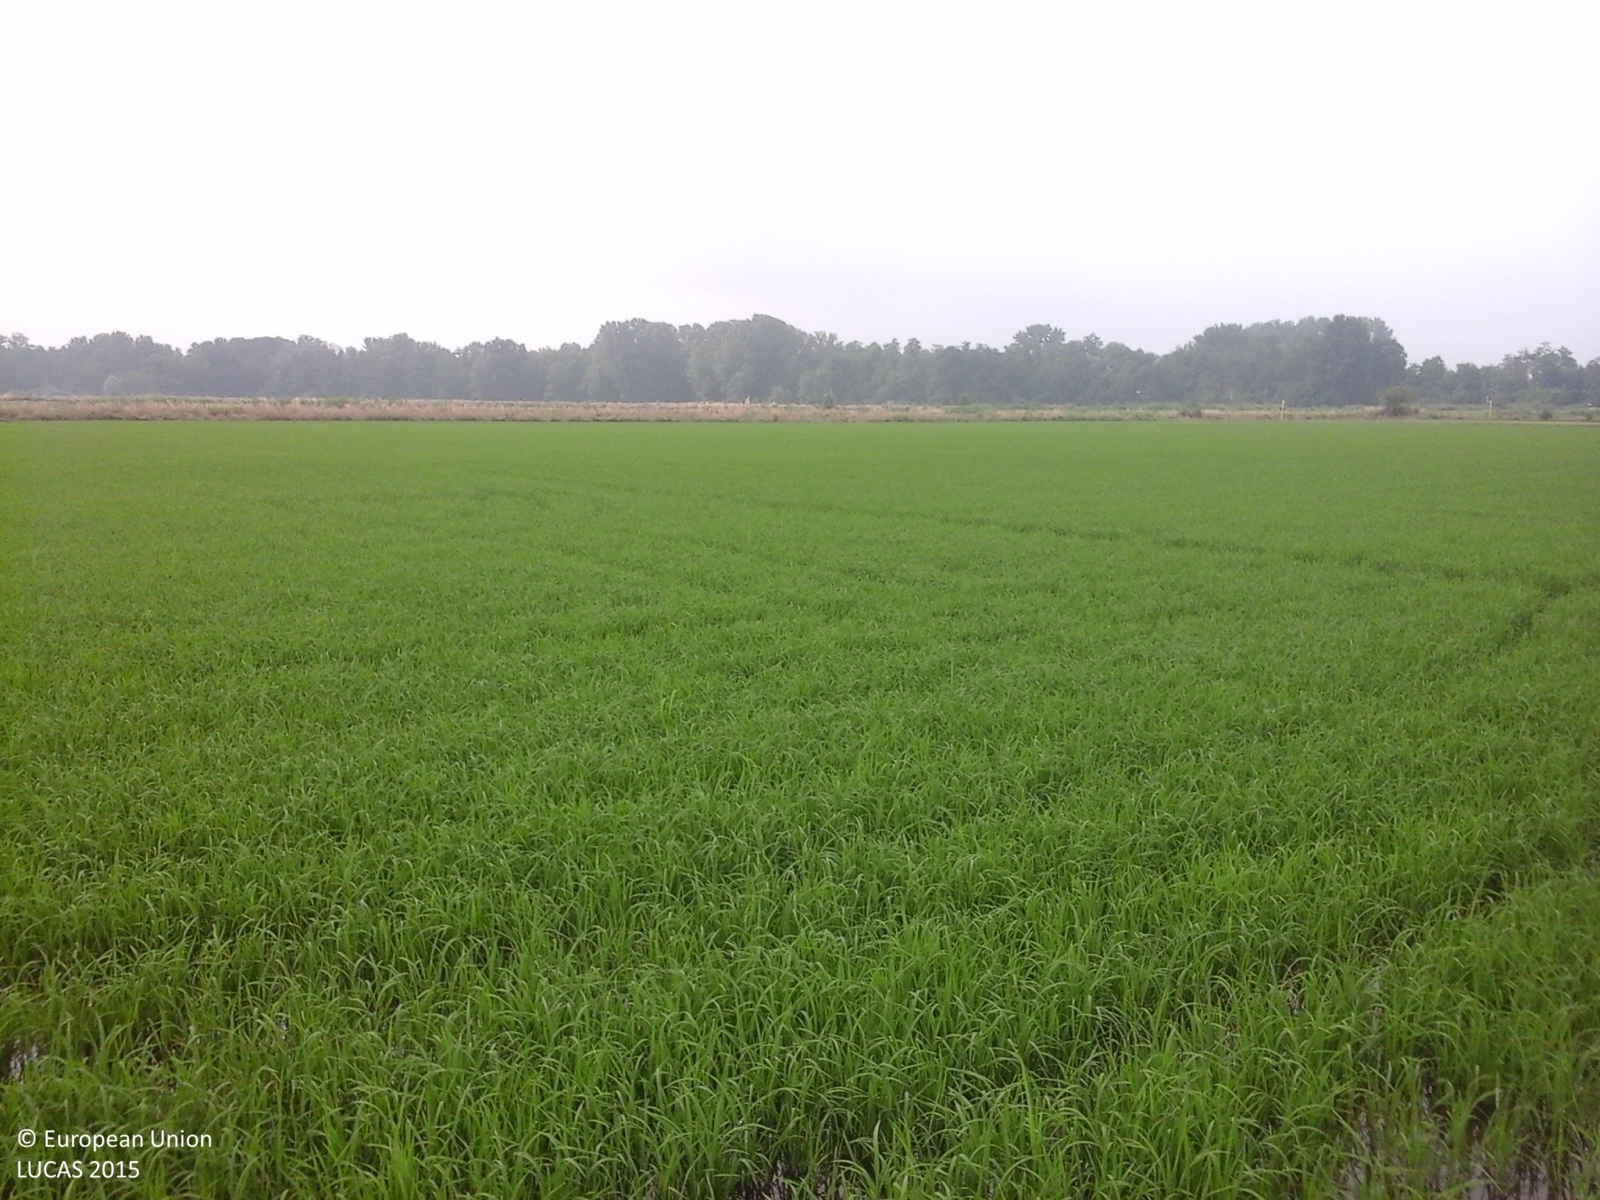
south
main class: Cropland
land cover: Rice
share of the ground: > 75 %
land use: Agriculture (excluding fallow land and kitchen gardens)
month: June
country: IT
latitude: 45.2072
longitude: 8.6402
